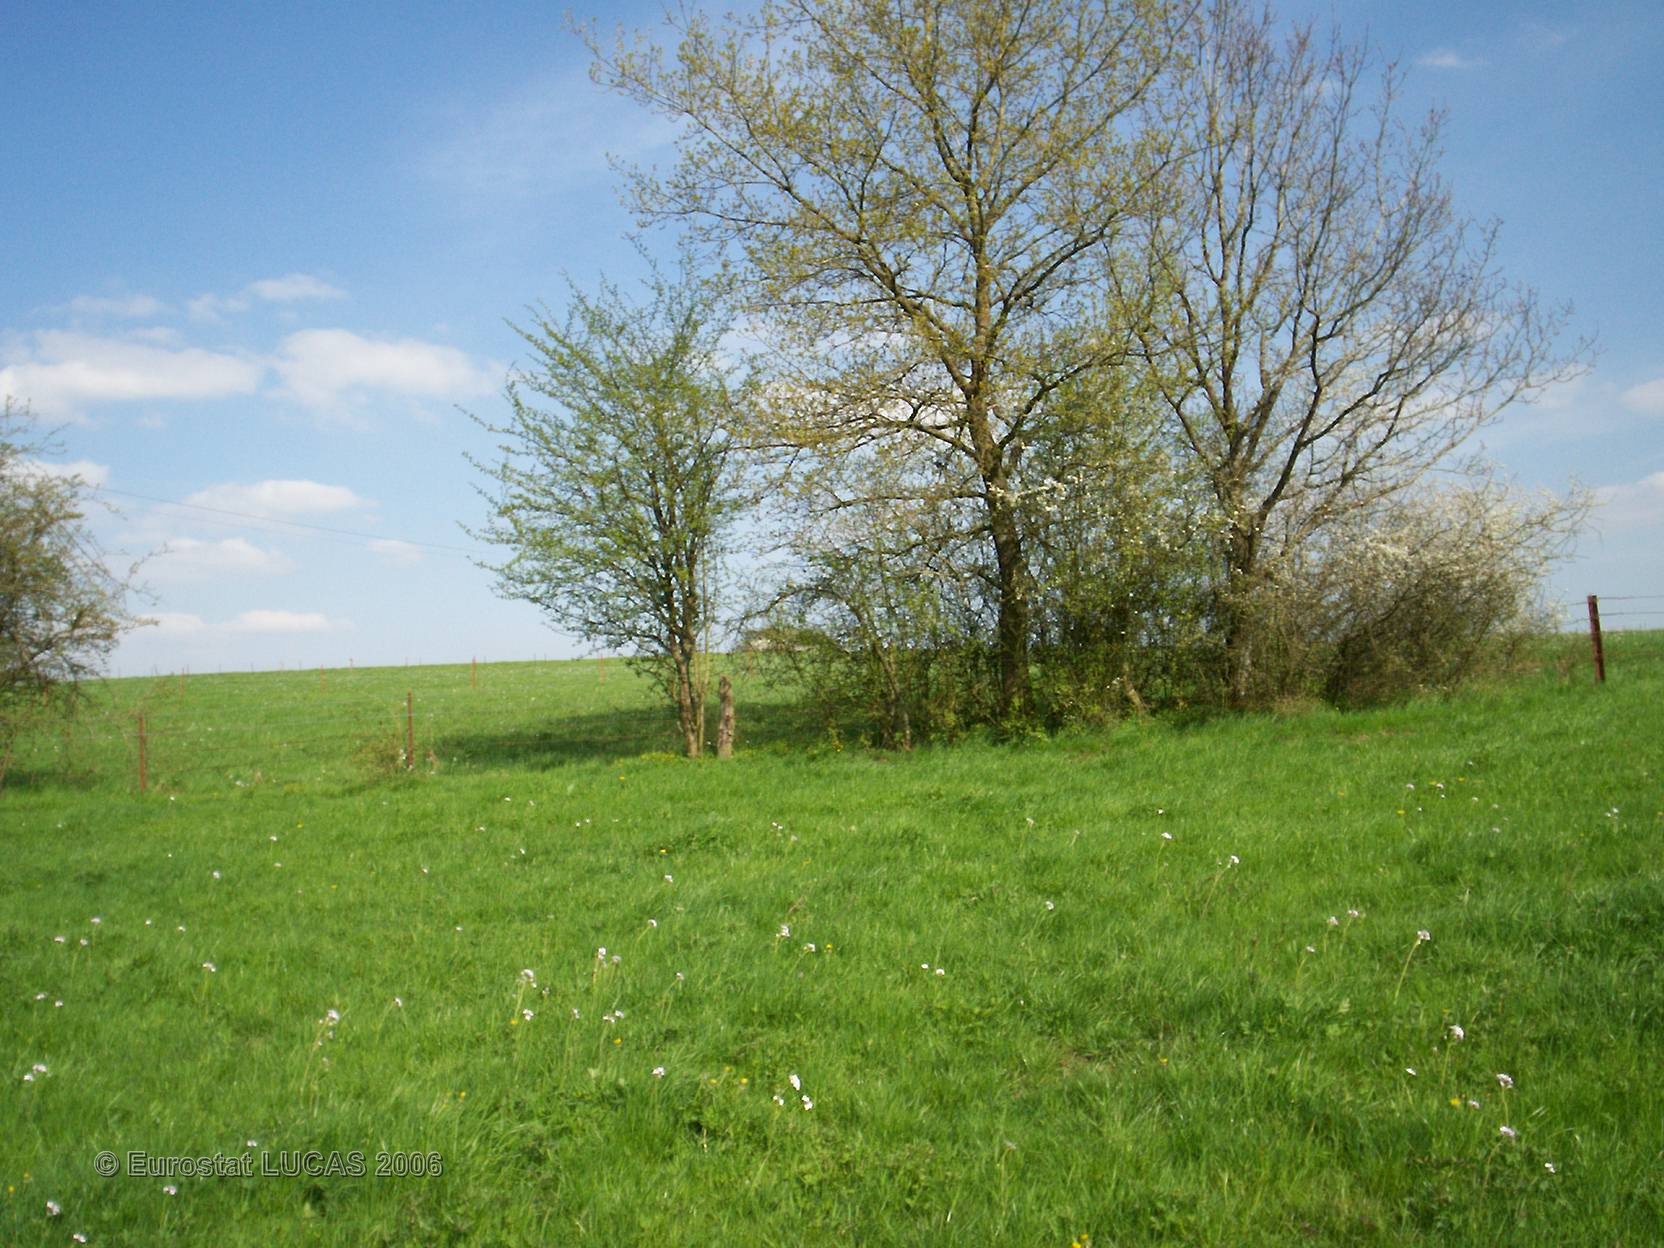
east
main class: Grassland
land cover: Grassland without tree/shrub cover
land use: Agriculture (excluding fallow land and kitchen gardens)
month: April
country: FR
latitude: 49.7349
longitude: 4.2930
